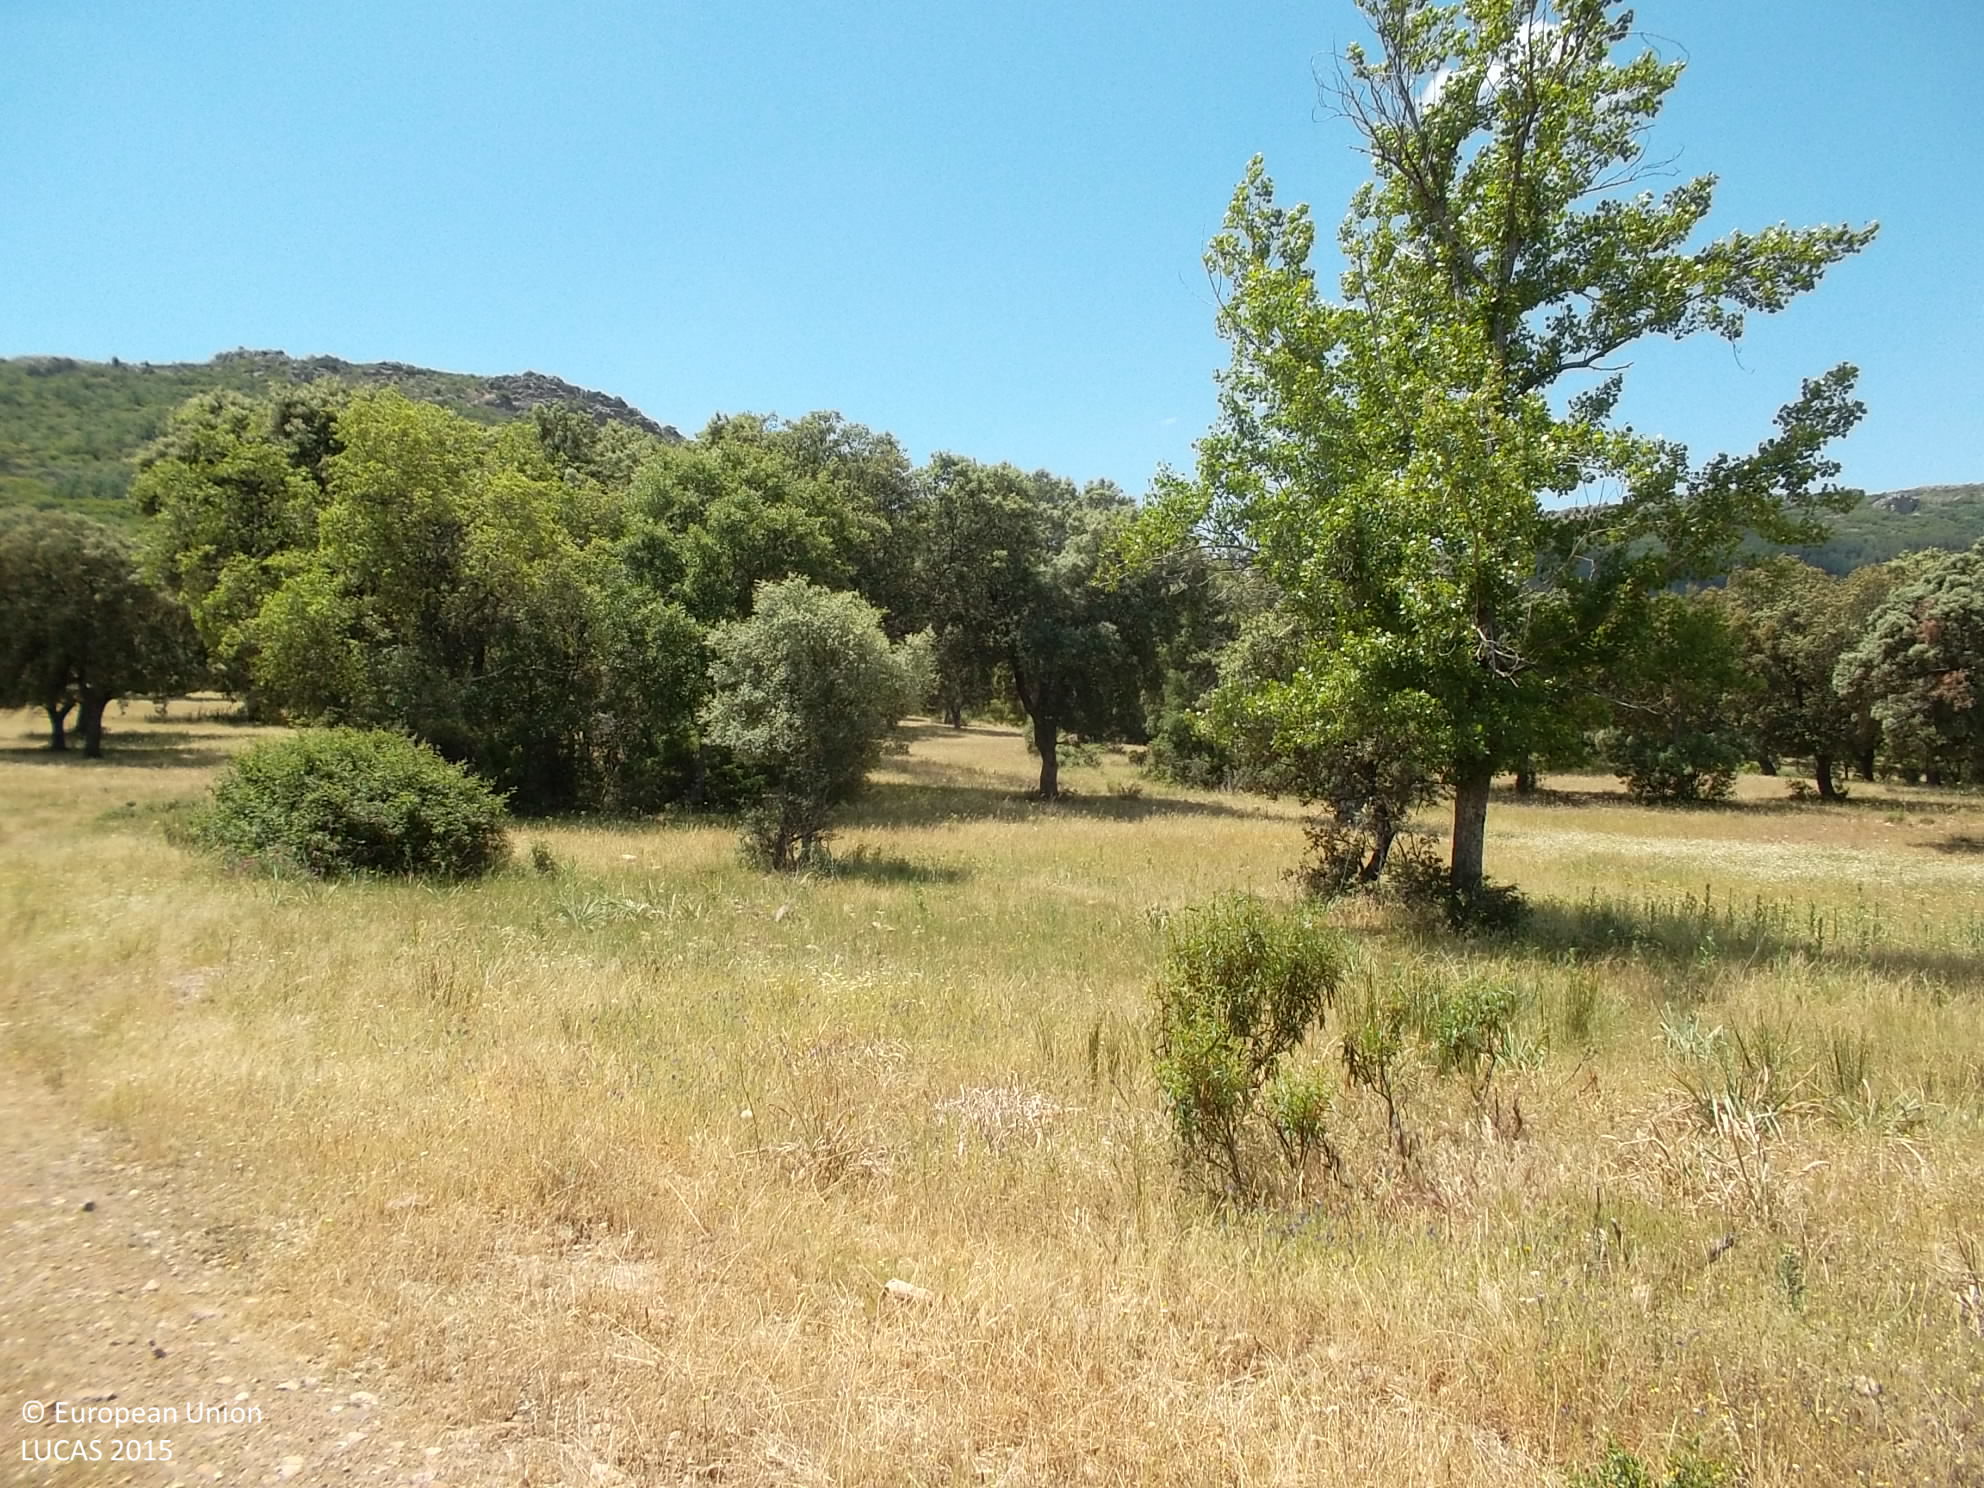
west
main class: Woodland
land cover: Broadleaved woodland
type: broadleaved evergreen forest
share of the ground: 25 - 50 %
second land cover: Spontaneously vegetated surfaces
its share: > 75 %
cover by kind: herbaceous plants 60 %, broadleaved forest trees 40 %
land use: Forestry
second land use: Agriculture (excluding fallow land and kitchen gardens)
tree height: > 5 m
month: May
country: ES
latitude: 38.5422
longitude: -4.3723
